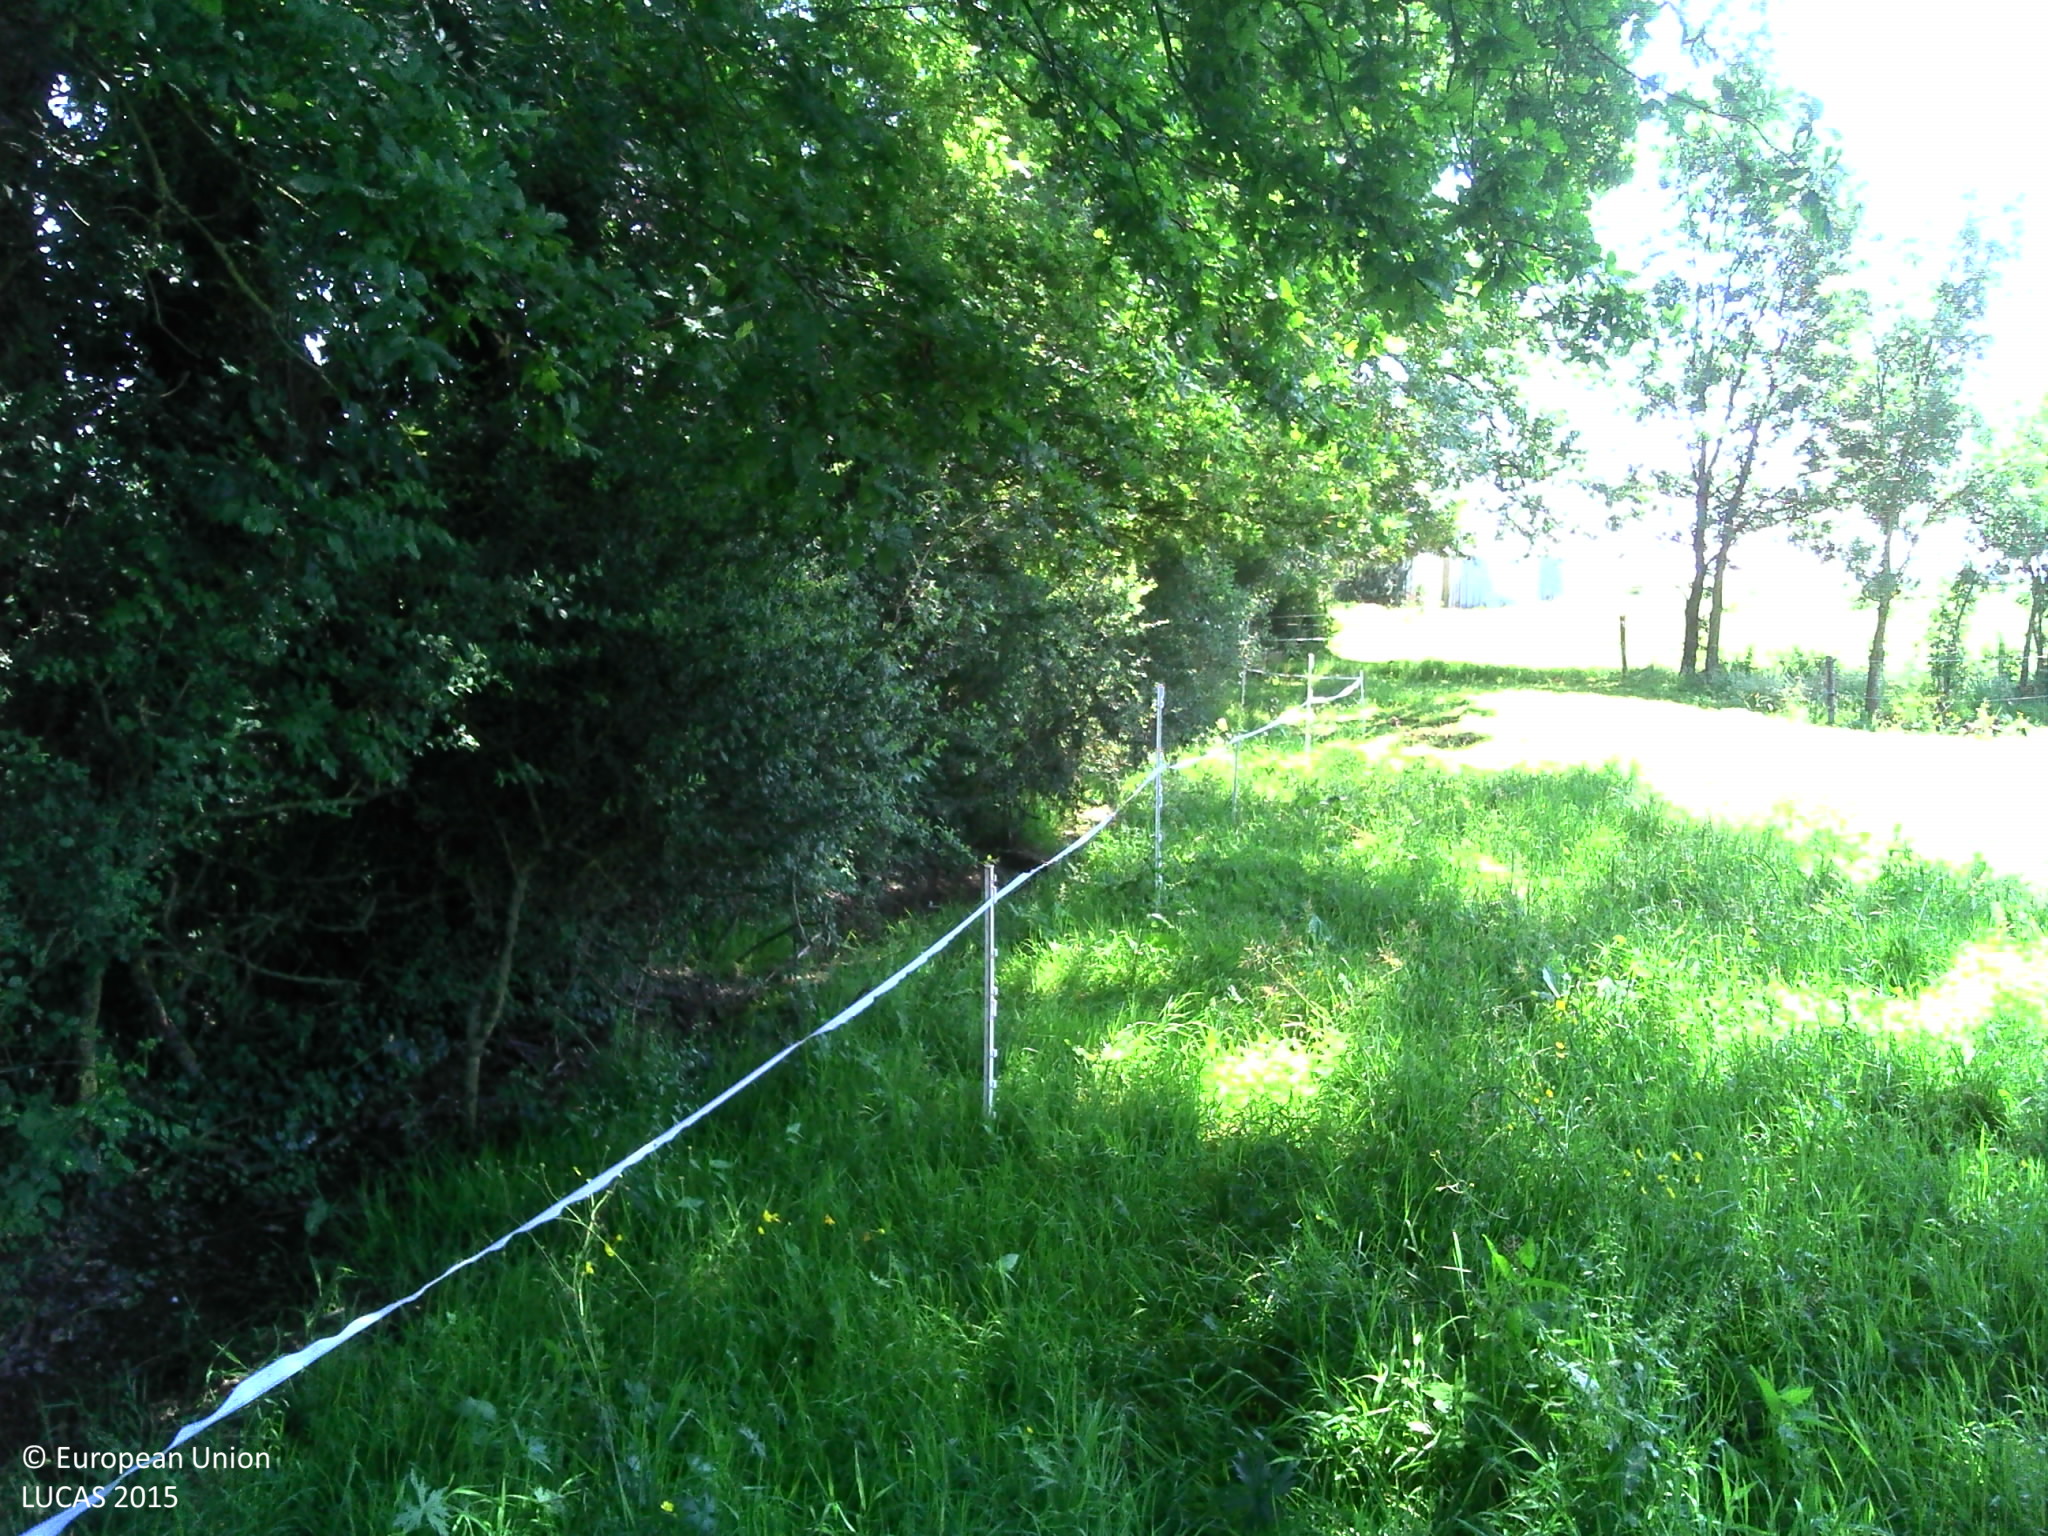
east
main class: Grassland
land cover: Grassland without tree/shrub cover
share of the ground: > 75 %
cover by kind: herbaceous plants 100 %
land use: Sport
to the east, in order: Grassland without tree/shrub cover; Fences; Lines of trees; Ditches and canals; Grass margins; Paved roads, cycling and walking lanes; Grass margins; Ditches and canals; Spontaneously vegetated surfaces; Grassland without tree/shrub cover; Ditches and canals; Fences; Managed hedges; Grassland with sparse tree/shrub cover; Fences; Grassland without tree/shrub cover; Spontaneously vegetated surfaces; Managed hedges; Electric lines; Temporary grasslands; Fences; Grassland without tree/shrub cover
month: June
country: FR
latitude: 46.8177
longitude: -1.3486
